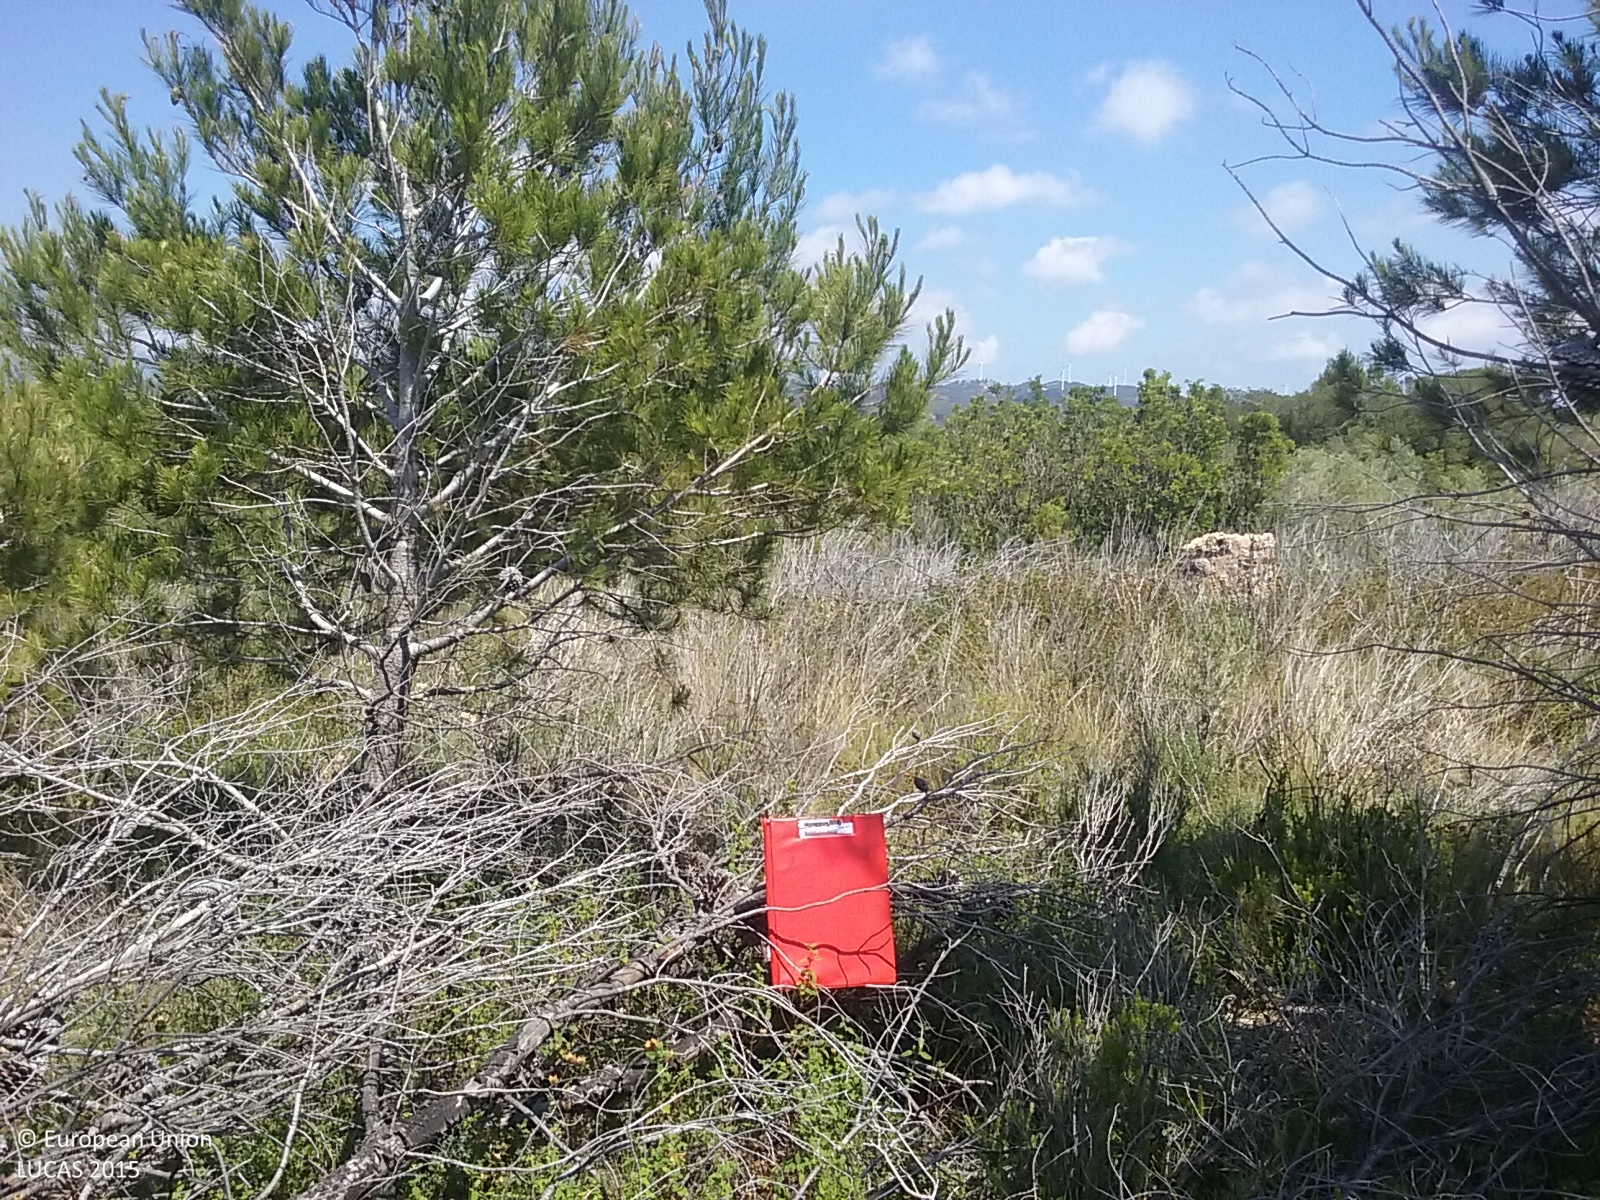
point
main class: Woodland
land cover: Pine dominated coniferous woodland
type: coniferous forest of the mediterranean region
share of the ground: 10 - 25 %
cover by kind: shrubs 75 %, coniferous forest trees 15 %, herbaceous plants 10 %
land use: Semi-natural and natural areas not in use
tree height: < 5 m
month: June
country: ES
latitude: 40.9297
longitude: 0.6470
